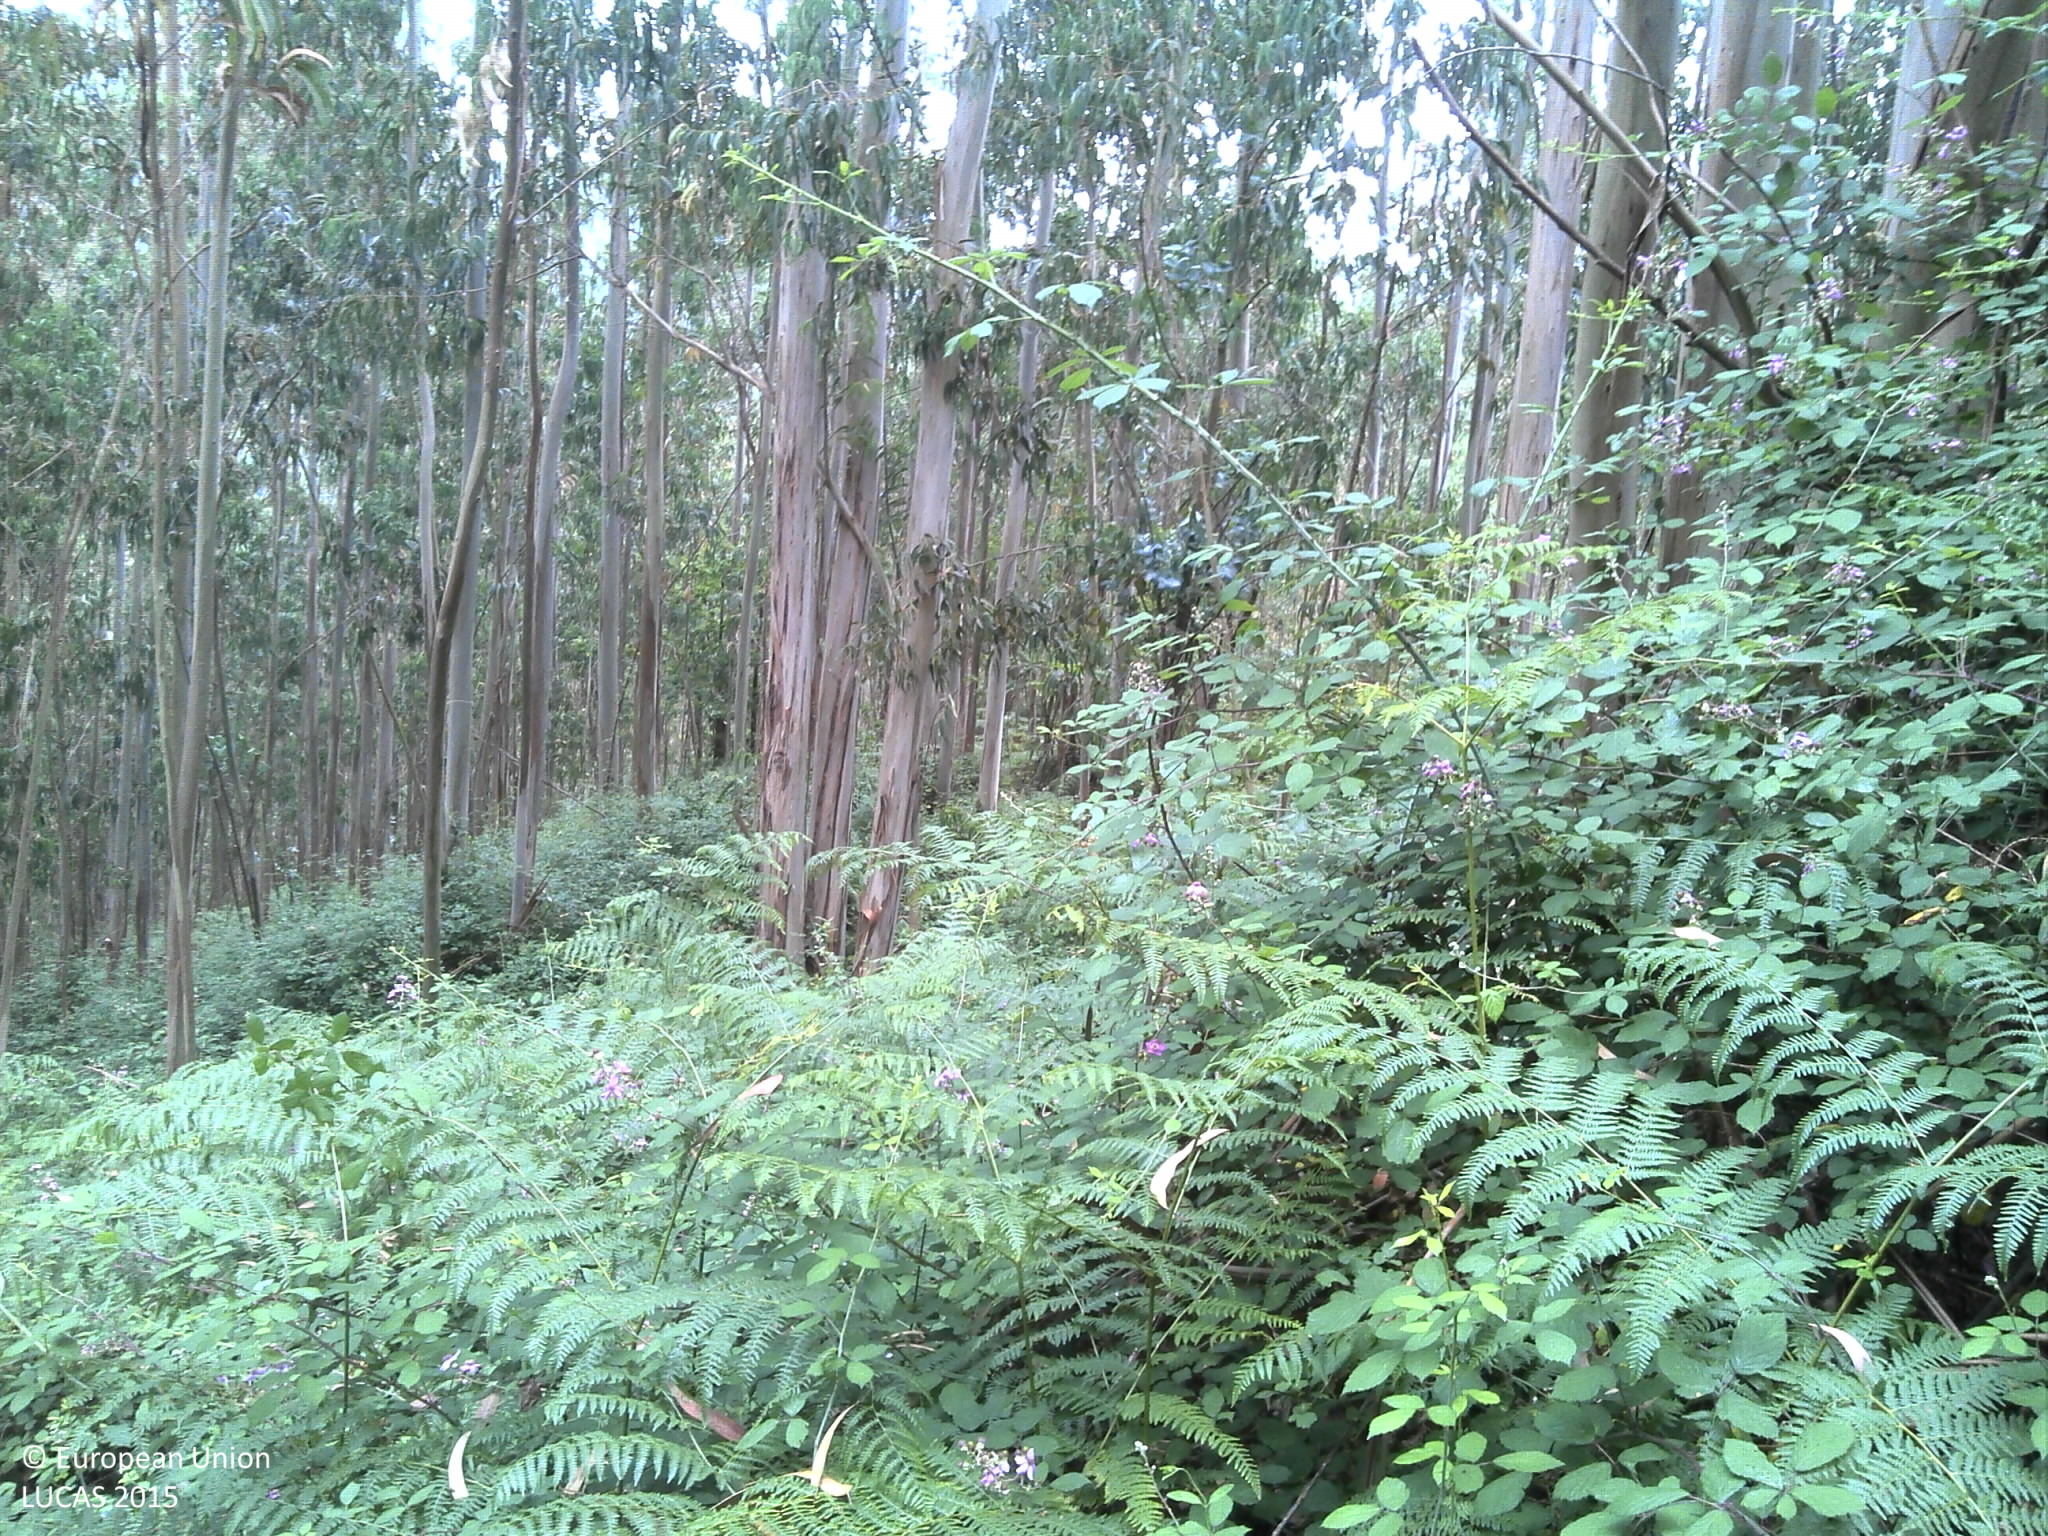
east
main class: Woodland
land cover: Broadleaved woodland
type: exotic forest
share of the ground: 50 - 75 %
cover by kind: broadleaved forest trees 70 %, shrubs 25 %, unconsolidated bare surface 5 %
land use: Forestry
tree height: > 5 m
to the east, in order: Broadleaved woodland; Shrubland with sparse tree cover; Broadleaved woodland; Shrubland with sparse tree cover; Broadleaved woodland
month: June
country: PT
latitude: 40.3471
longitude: -8.3679
